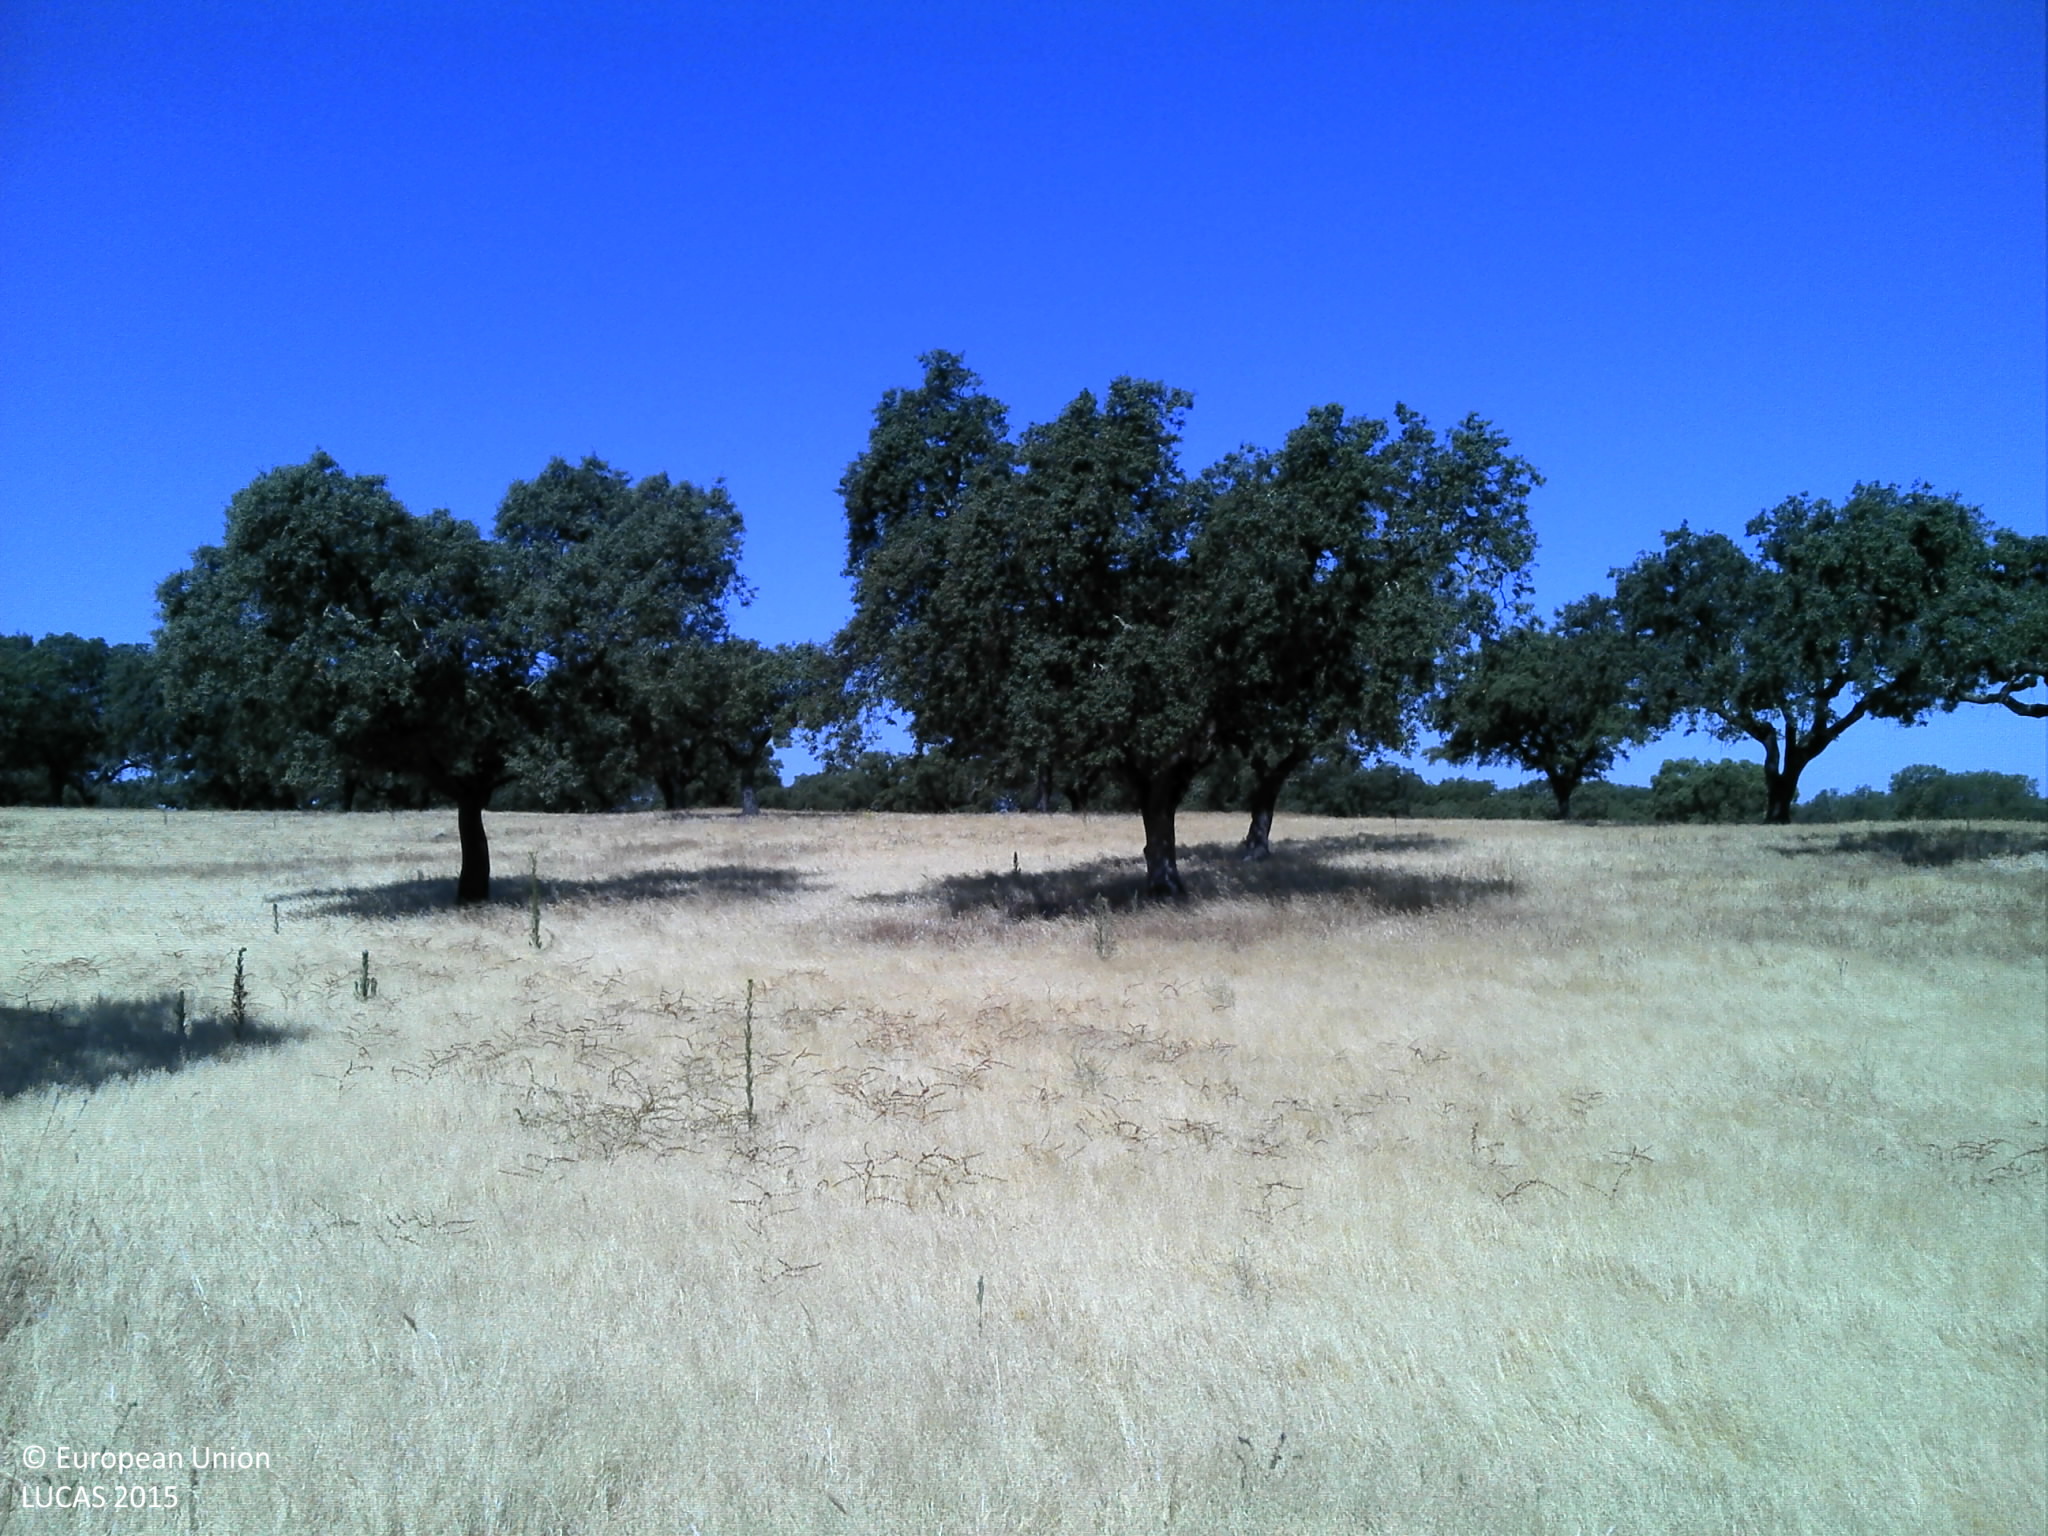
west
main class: Woodland
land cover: Broadleaved woodland
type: broadleaved evergreen forest
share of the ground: 10 - 25 %
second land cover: Grassland without tree/shrub cover
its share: 50 - 75 %
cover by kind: herbaceous plants 60 %, broadleaved forest trees 30 %, consolidated bare surface 10 %
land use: Forestry
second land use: Agriculture (excluding fallow land and kitchen gardens)
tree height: > 5 m
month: June
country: PT
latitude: 38.8610
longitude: -7.9193
